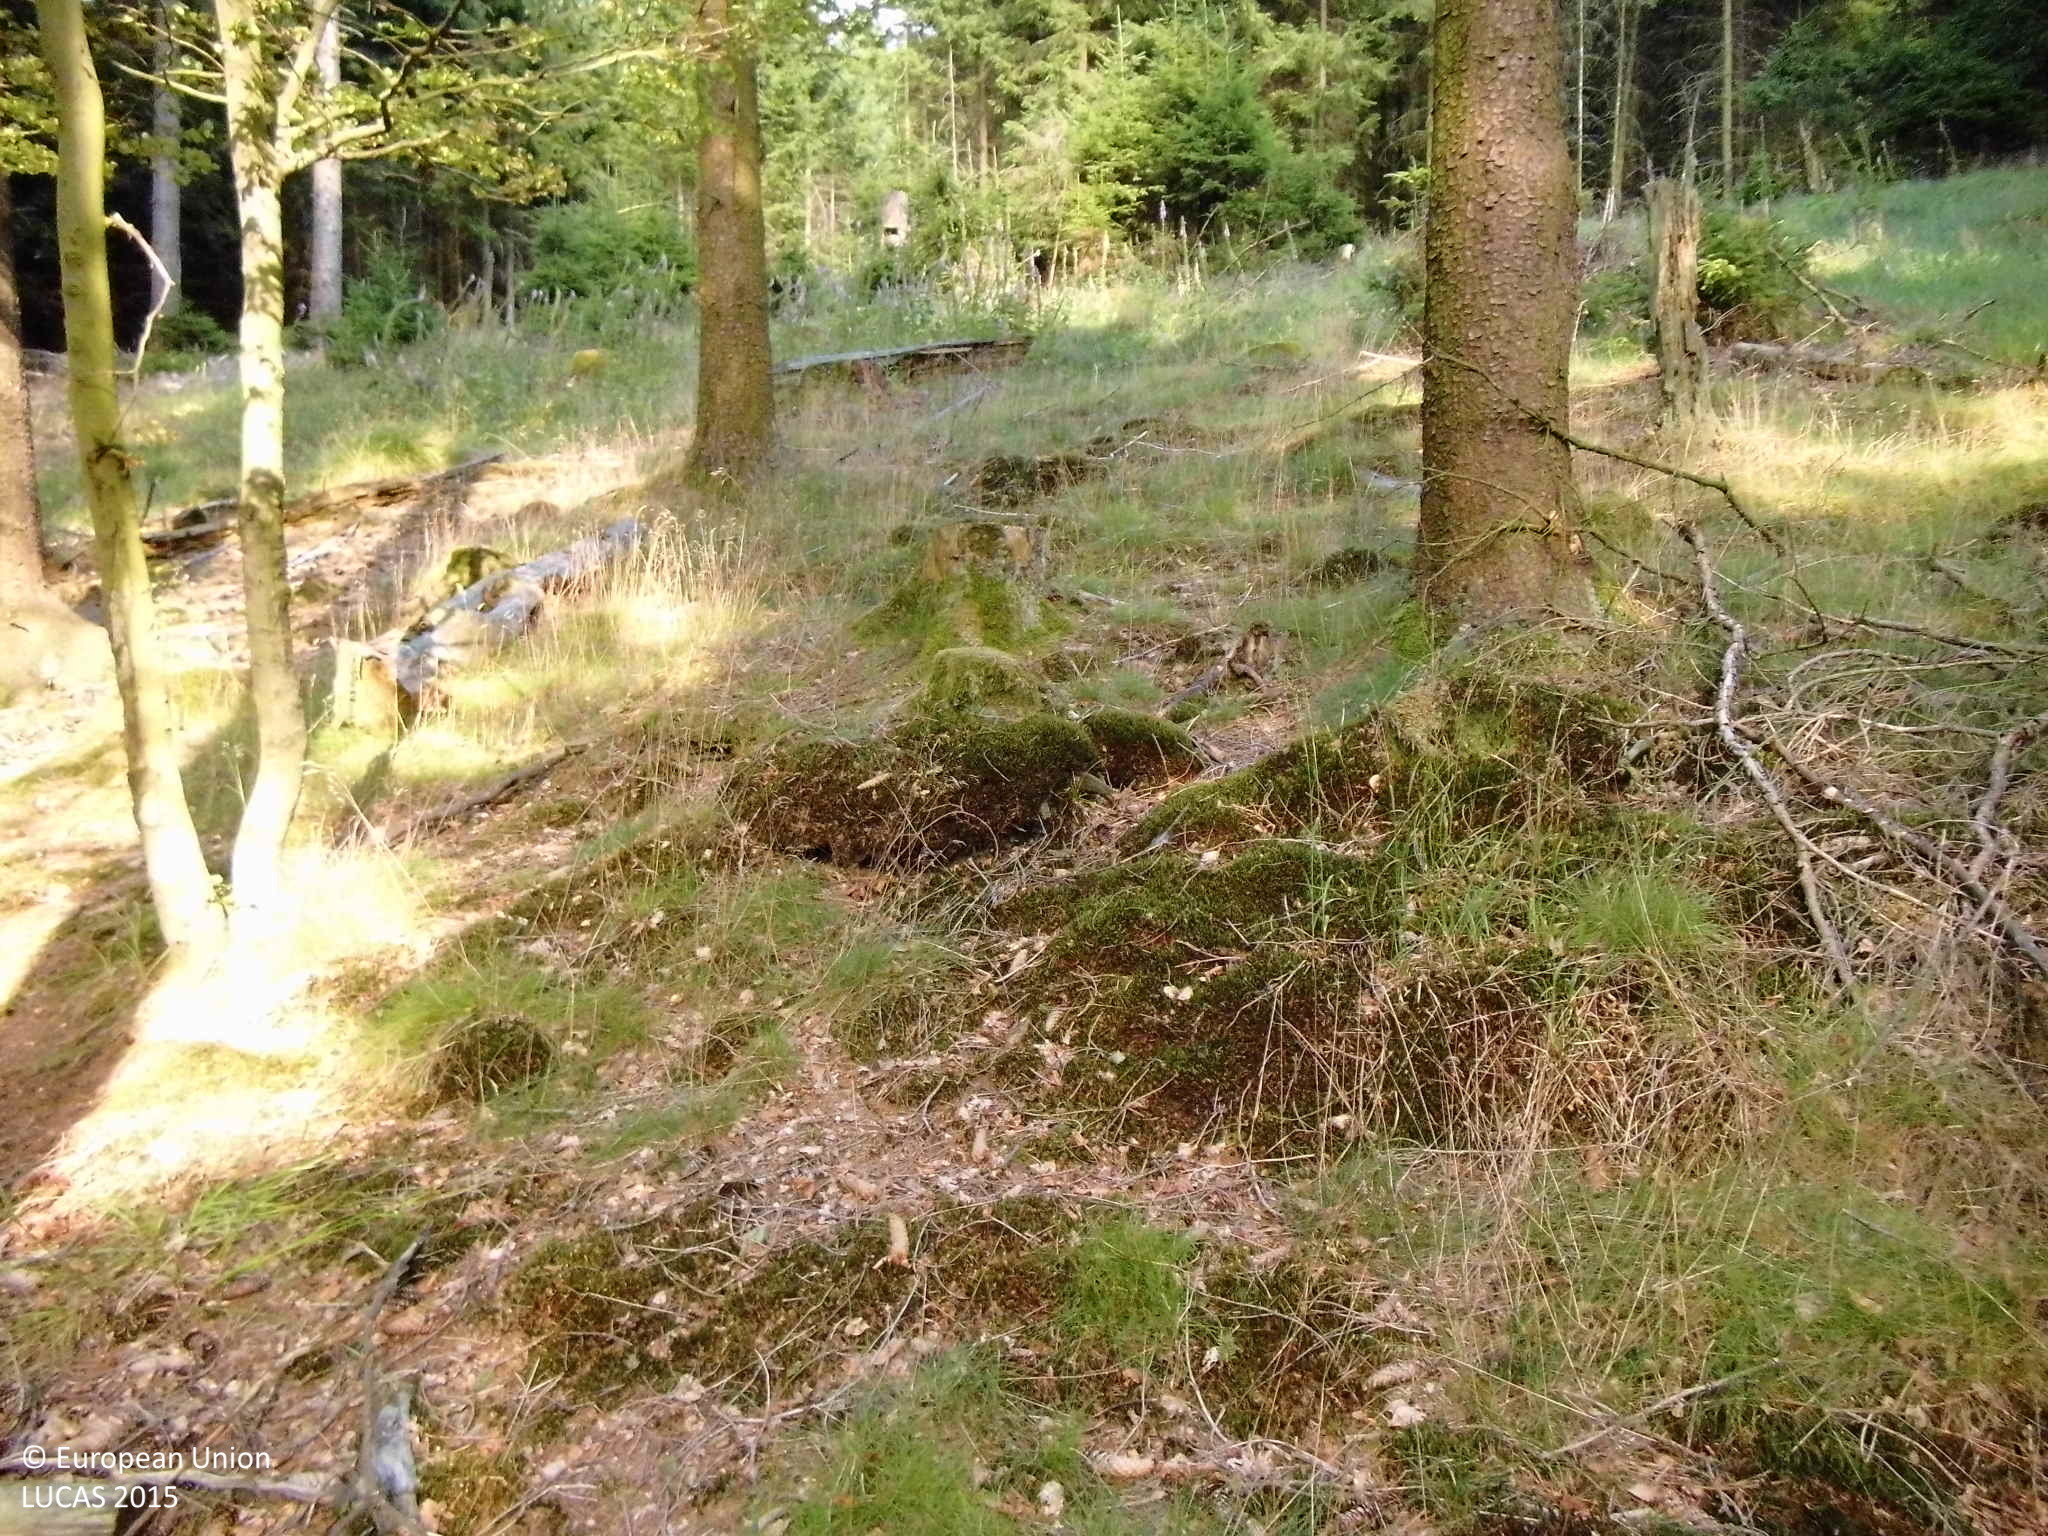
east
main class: Woodland
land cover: Spruce dominated mixed woodland
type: hemiboreal forest and nemoral coniferous forest and mixed broadleaved-coniferous forest
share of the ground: > 75 %
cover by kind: coniferous forest trees 40 %, broadleaved forest trees 40 %, herbaceous plants 10 %, lichens and mosses 5 %, unconsolidated bare surface 5 %
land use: Forestry
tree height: > 5 m
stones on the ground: < 10 %
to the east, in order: Spruce dominated mixed woodland; Grassland with sparse tree/shrub cover; Grassland without tree/shrub cover; Spruce dominated coniferous woodland; Grassland without tree/shrub cover; Spruce dominated coniferous woodland; Tracks; Grassland without tree/shrub cover; Spruce dominated coniferous woodland; Grassland without tree/shrub cover; Spruce dominated coniferous woodland
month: August
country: DE
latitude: 51.1271
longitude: 8.4714
